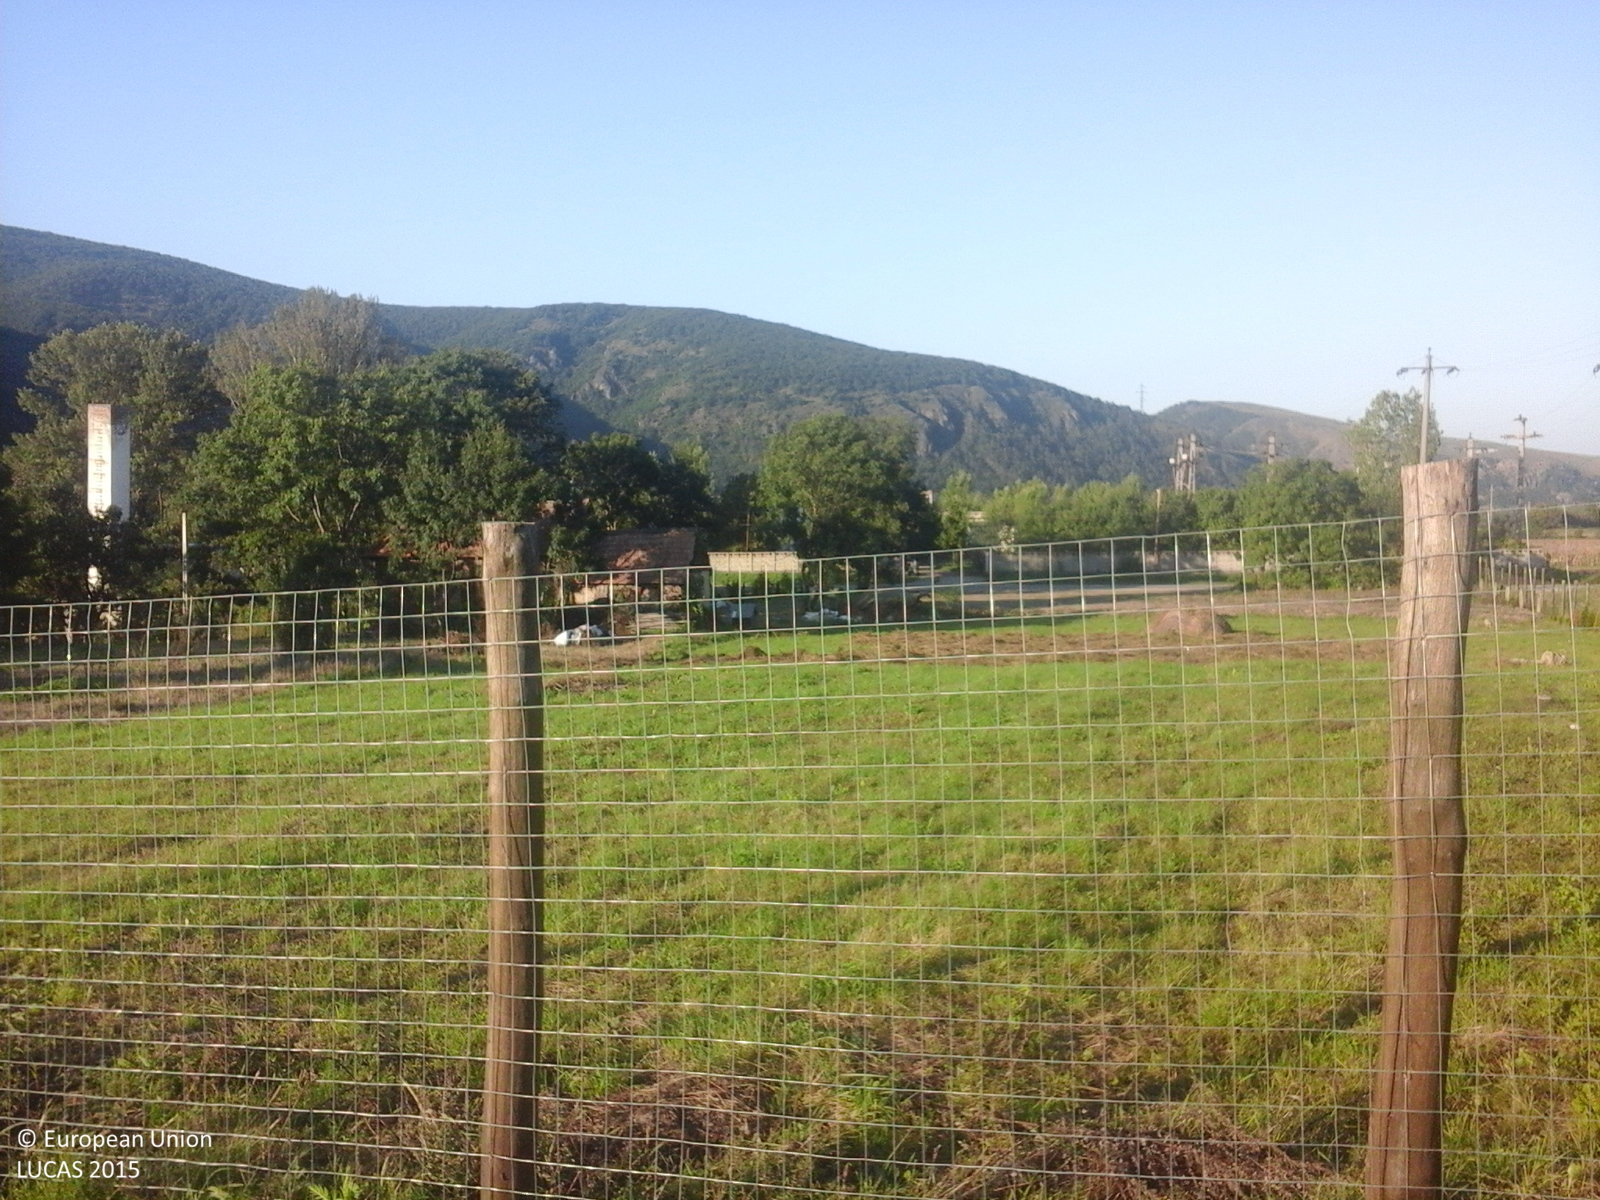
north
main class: Grassland
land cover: Grassland without tree/shrub cover
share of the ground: > 75 %
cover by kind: herbaceous plants 100 %
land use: Agriculture (excluding fallow land and kitchen gardens)
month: October
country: RO
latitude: 46.5100
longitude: 23.6637
